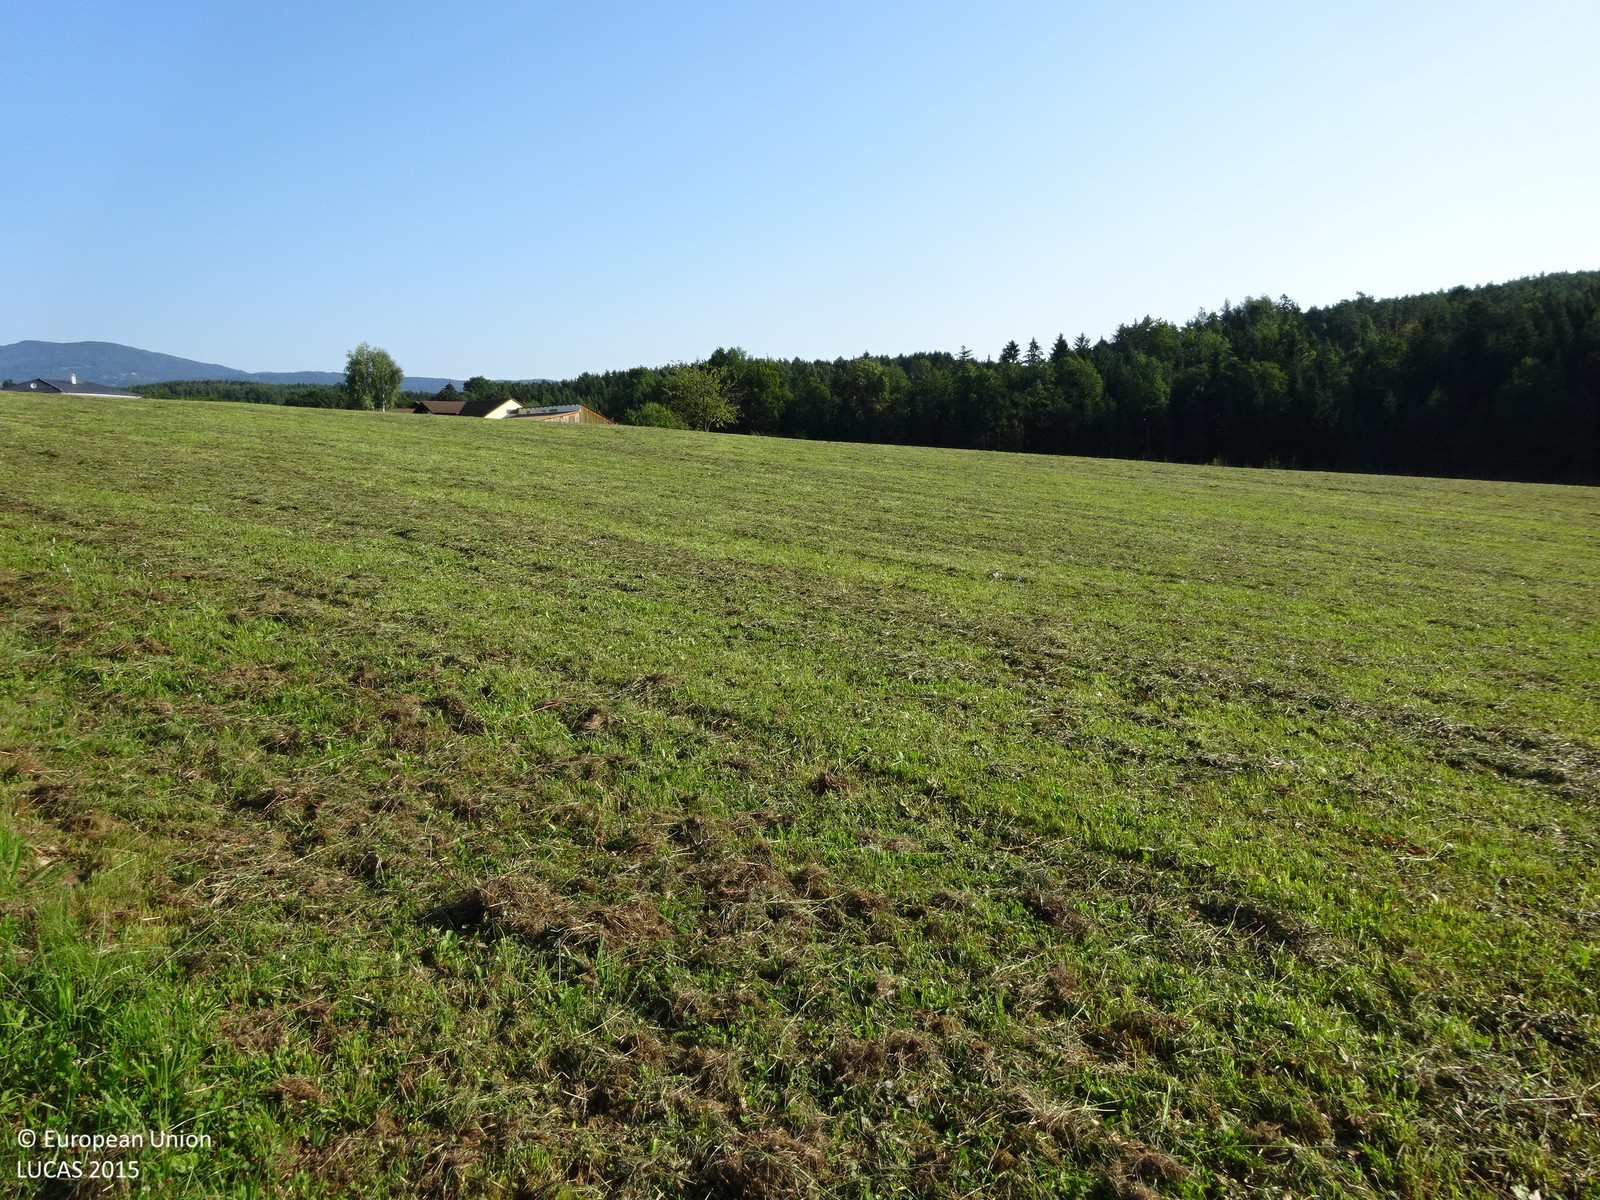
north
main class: Grassland
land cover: Grassland without tree/shrub cover
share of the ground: > 75 %
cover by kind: herbaceous plants 100 %
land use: Agriculture (excluding fallow land and kitchen gardens)
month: August
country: AT
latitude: 47.3908
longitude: 16.0298
